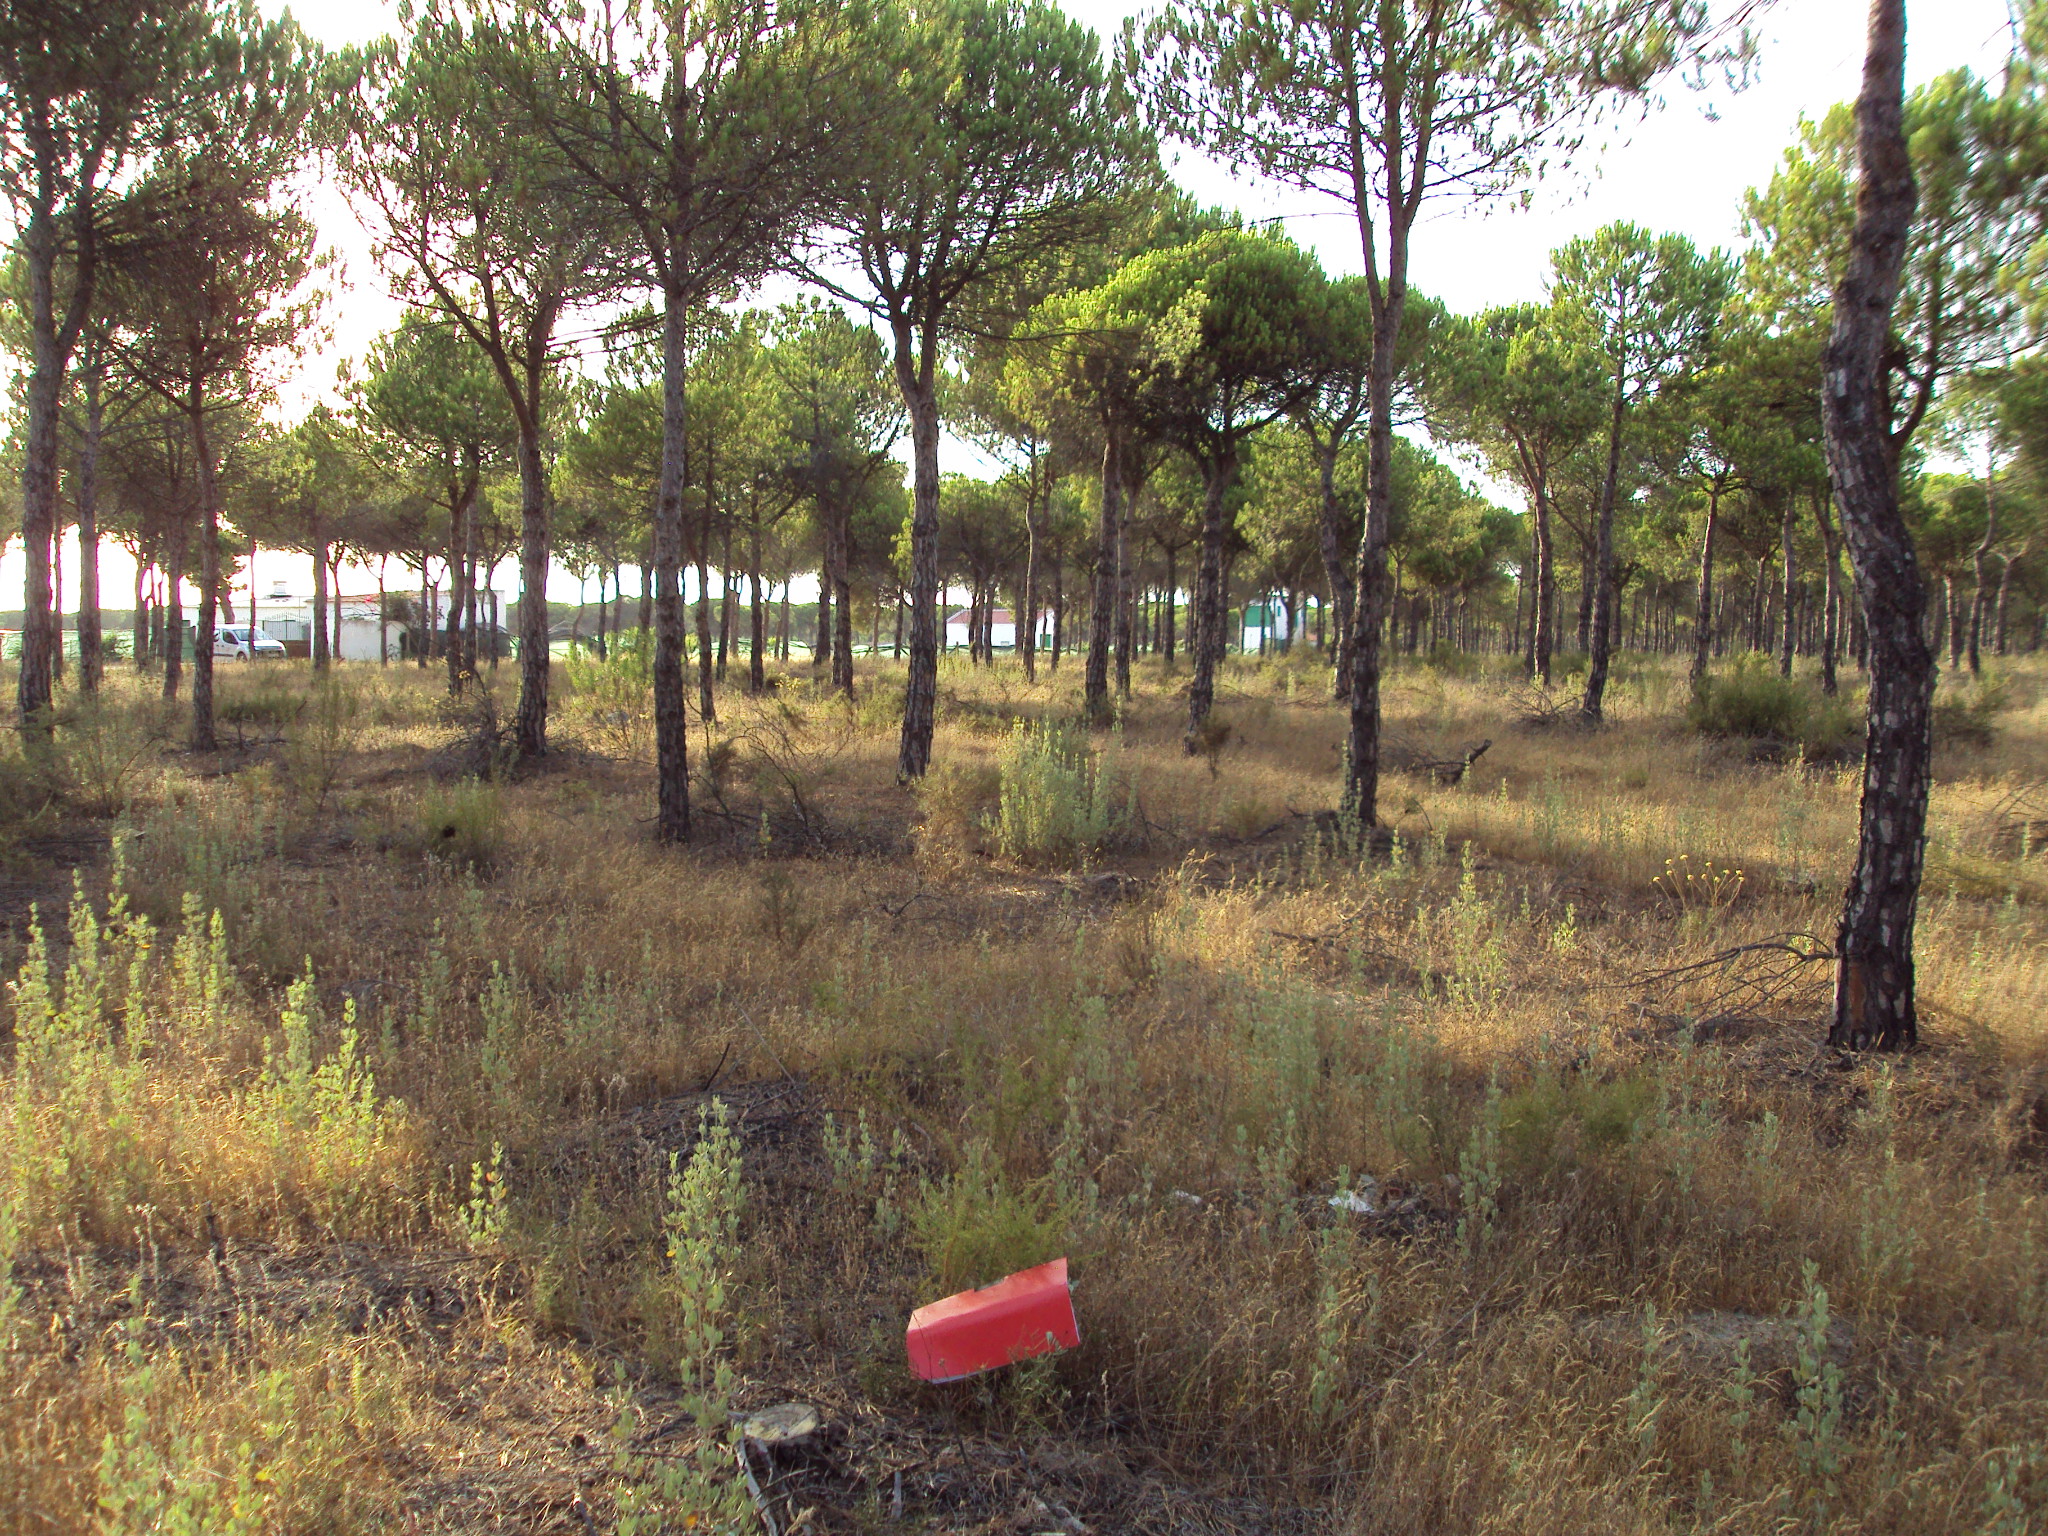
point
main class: Woodland
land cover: Pine dominated coniferous woodland
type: coniferous forest of the mediterranean region
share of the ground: 50 - 75 %
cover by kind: coniferous forest trees 60 %, shrubs 20 %, herbaceous plants 20 %
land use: Forestry
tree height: > 5 m
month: July
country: ES
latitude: 37.1429
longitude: -6.8193
